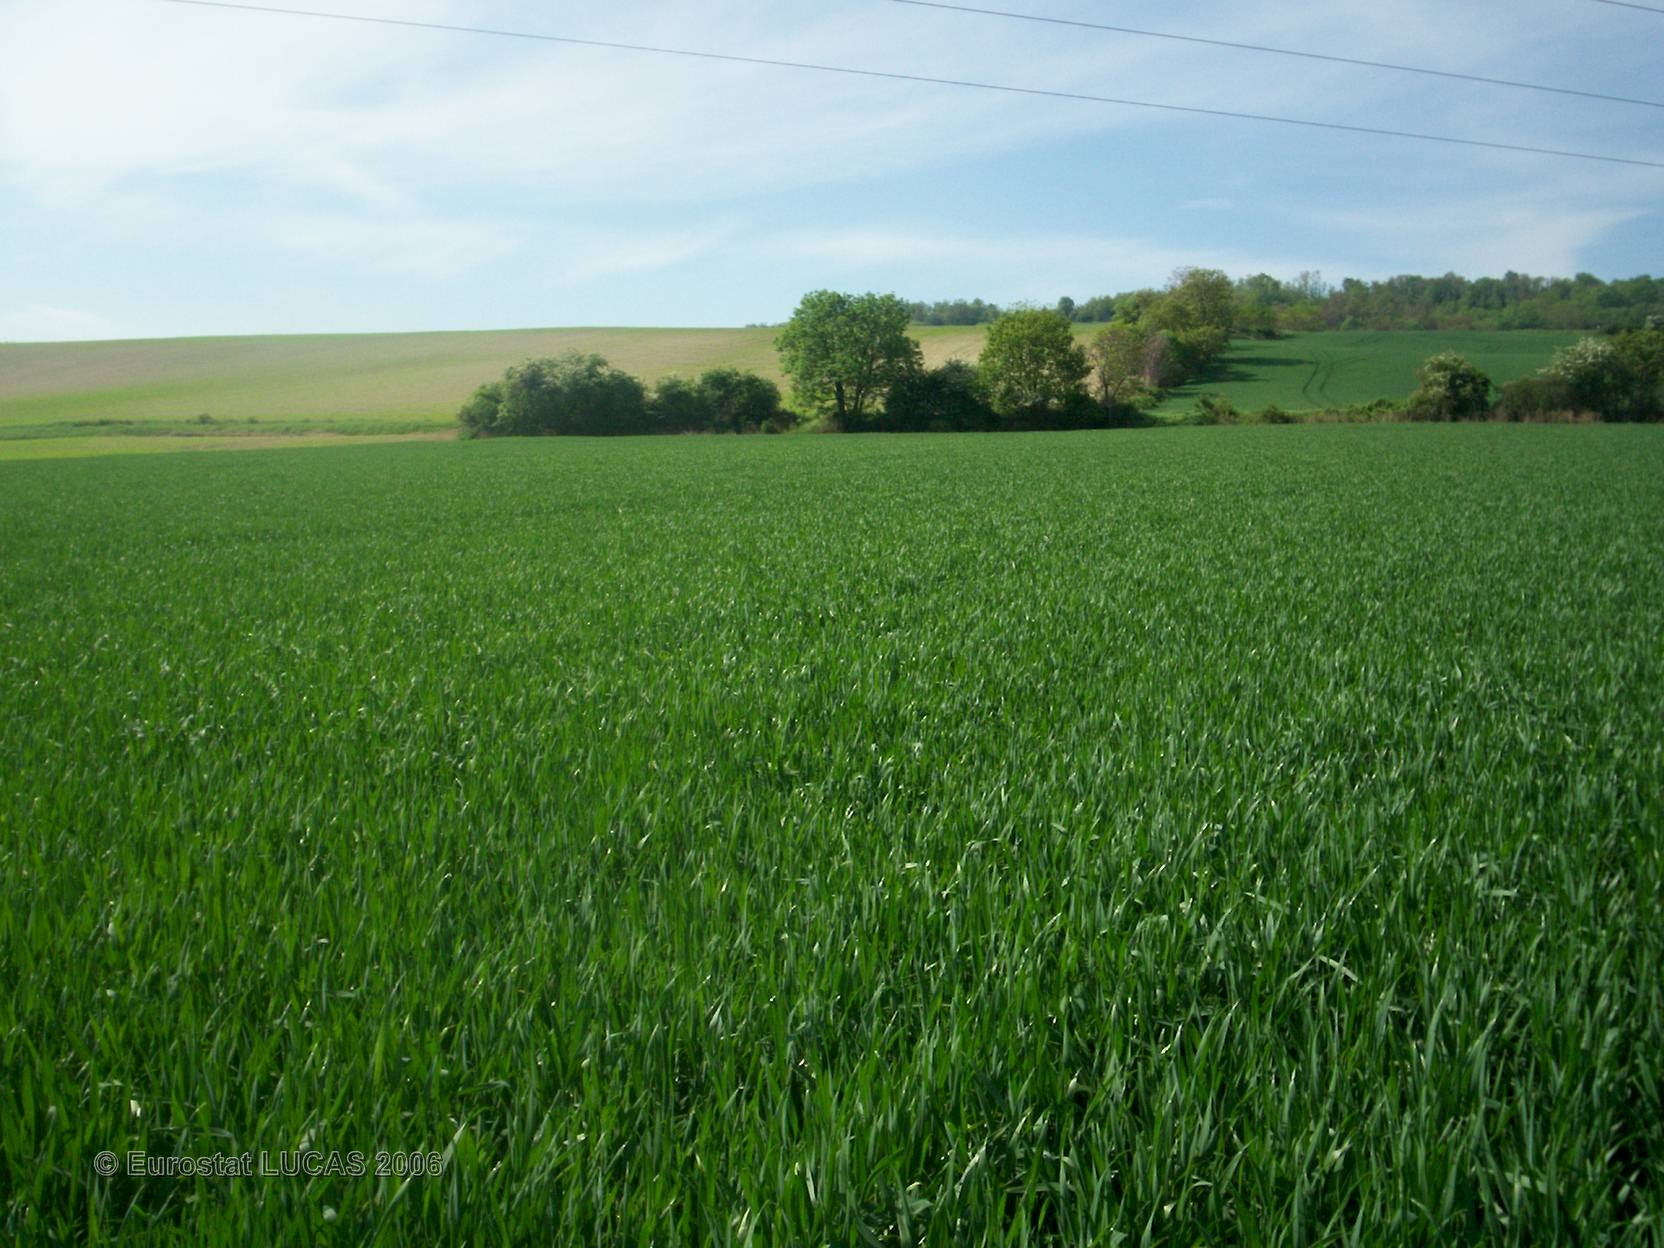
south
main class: Cropland
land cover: Common wheat
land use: Agriculture (excluding fallow land and kitchen gardens)
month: May
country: FR
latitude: 45.5382
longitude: 3.2007
